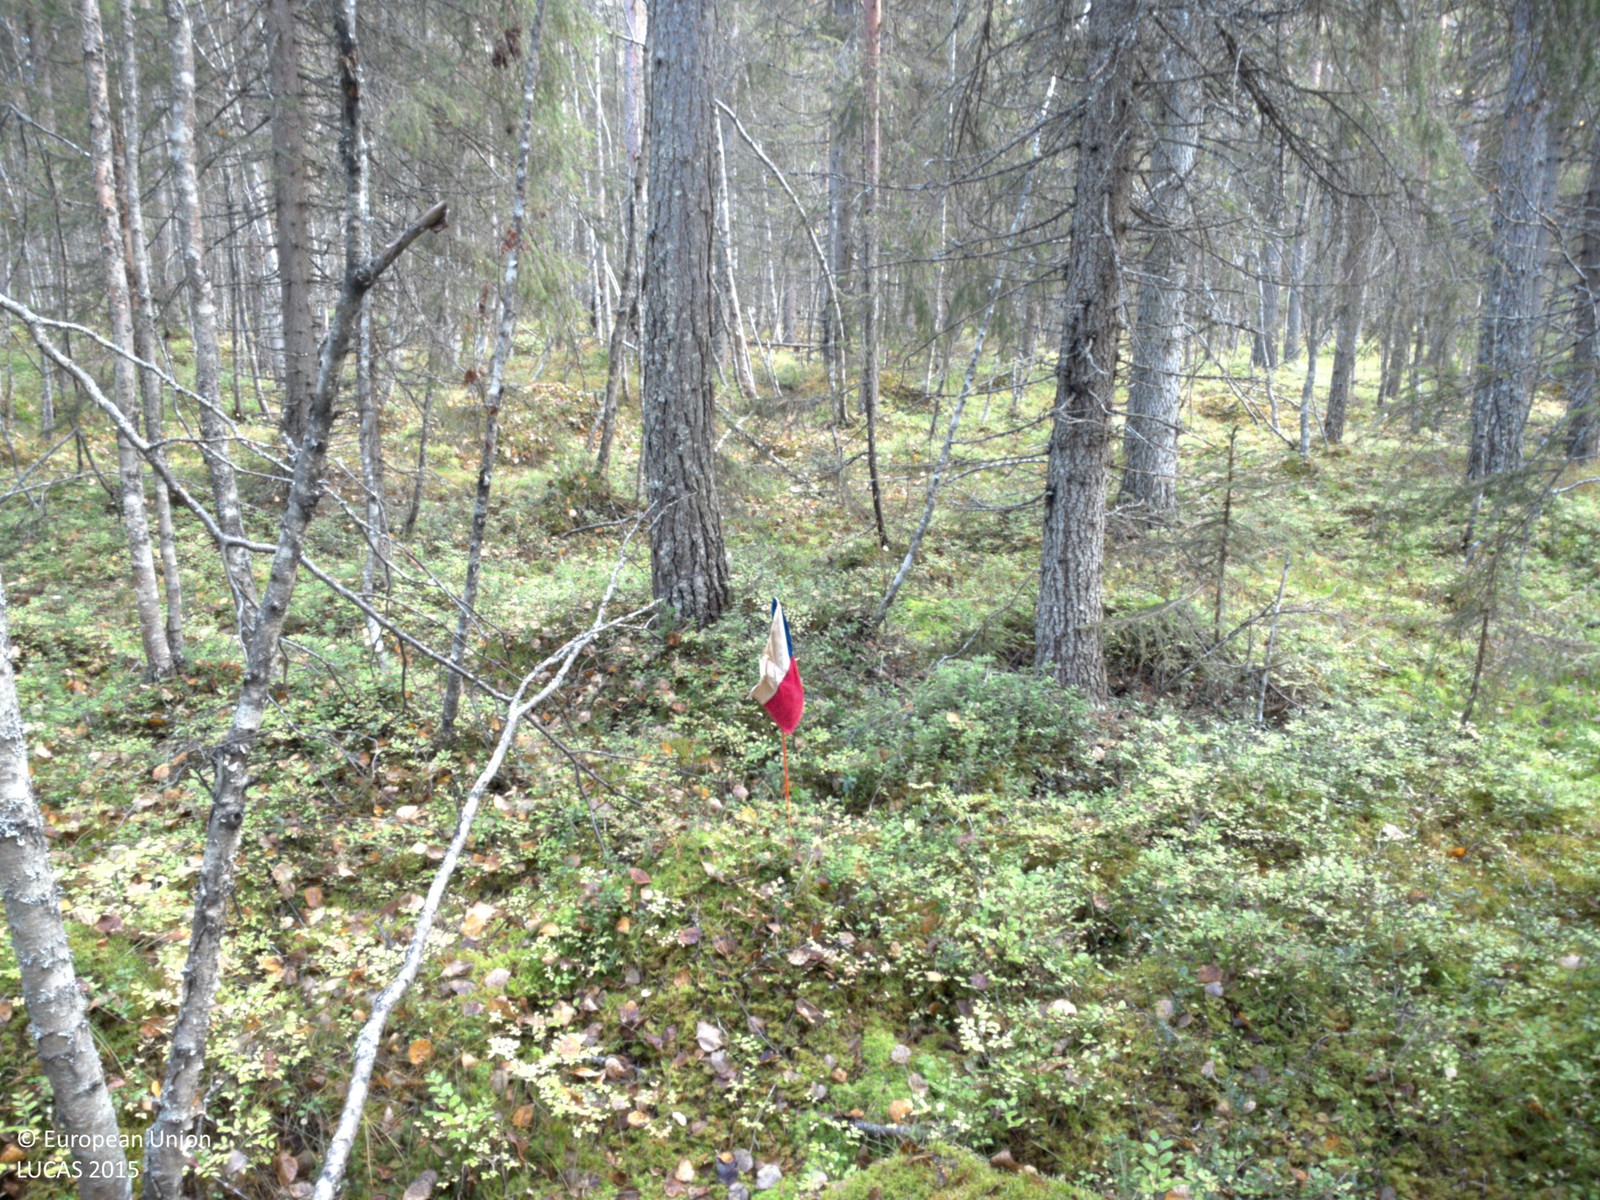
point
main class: Woodland
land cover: Spruce dominated coniferous woodland
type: boreal forest
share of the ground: > 75 %
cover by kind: coniferous forest trees 80 %, shrubs 10 %, broadleaved forest trees 5 %, lichens and mosses 5 %
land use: Forestry
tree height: > 5 m
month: September
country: SE
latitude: 65.0841
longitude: 18.4090
